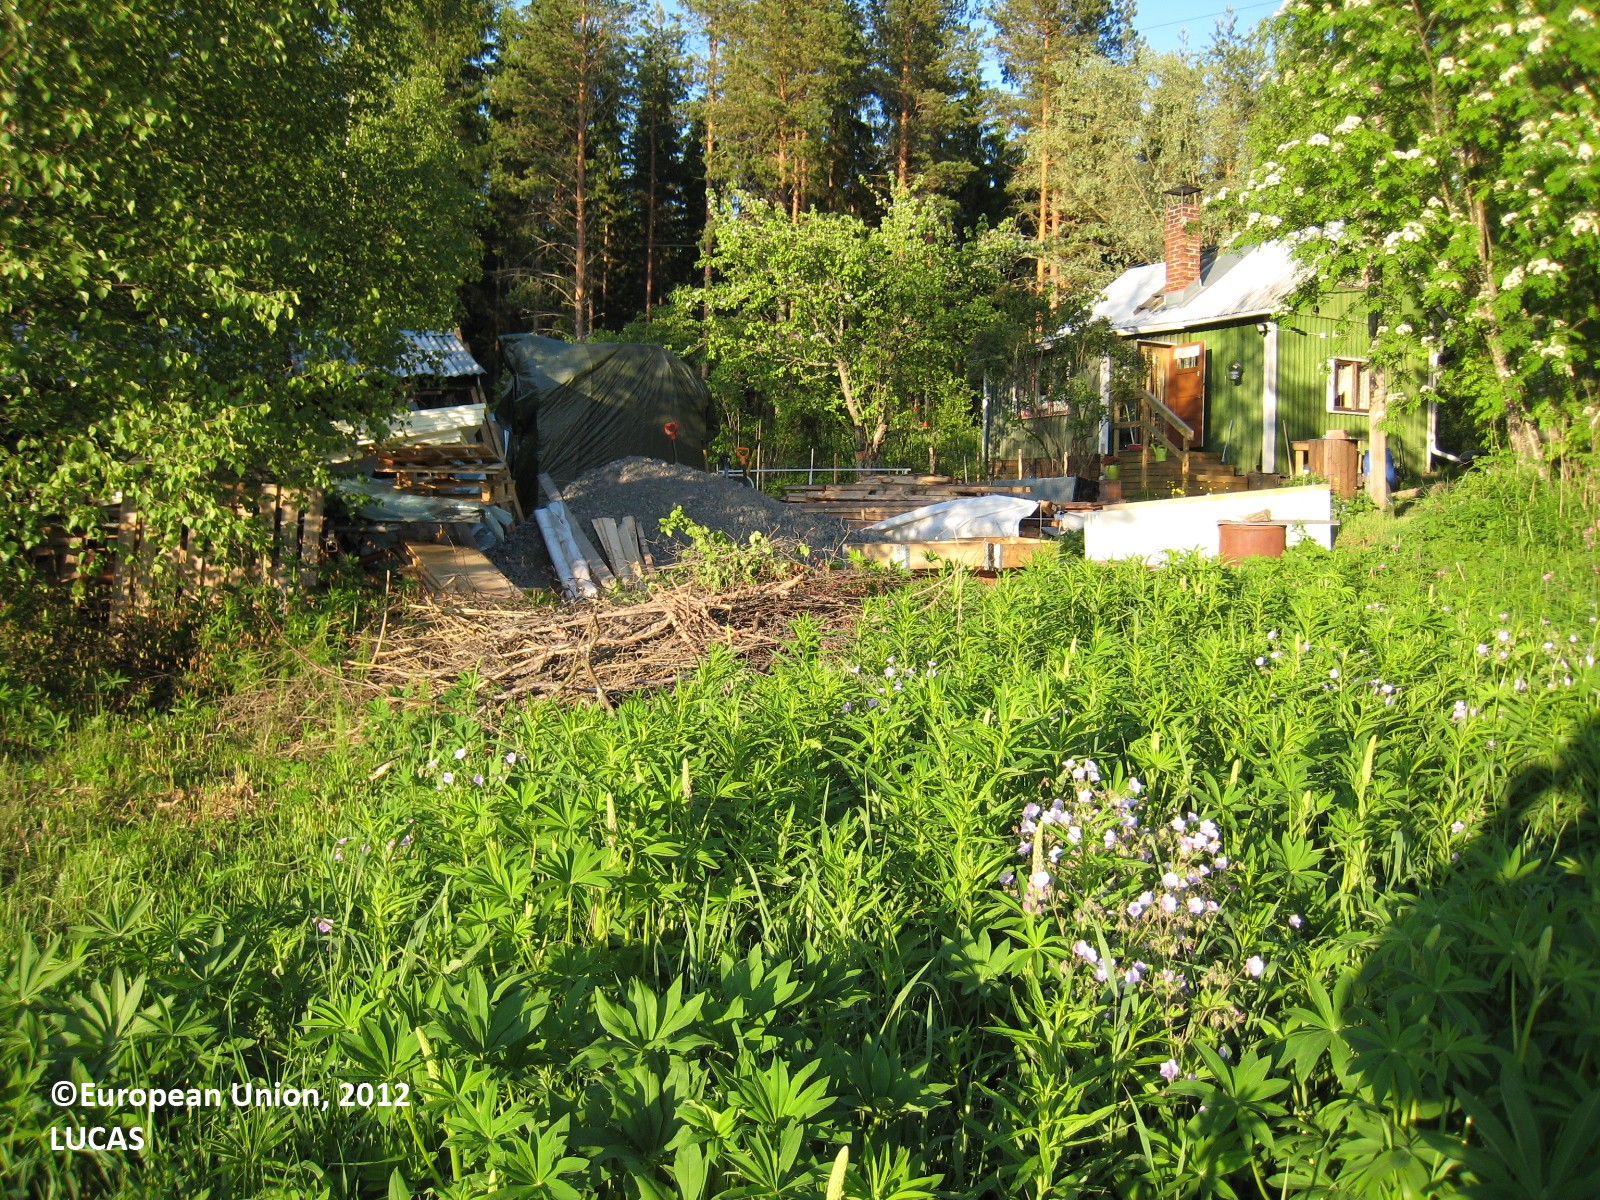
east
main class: Grassland
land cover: Spontaneously vegetated surfaces
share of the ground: > 75 %
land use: Fallow land
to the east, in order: Spontaneously vegetated surfaces; Other bare soil; Shruby margins; Artificial constructions in urban areas; Ditches and canals; Paved roads, cycling and walking lanes; Ditches and canals; Electric lines; Pine dominated coniferous woodland; Spruce dominated coniferous woodland
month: June
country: FI
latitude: 62.1318
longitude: 25.8685
